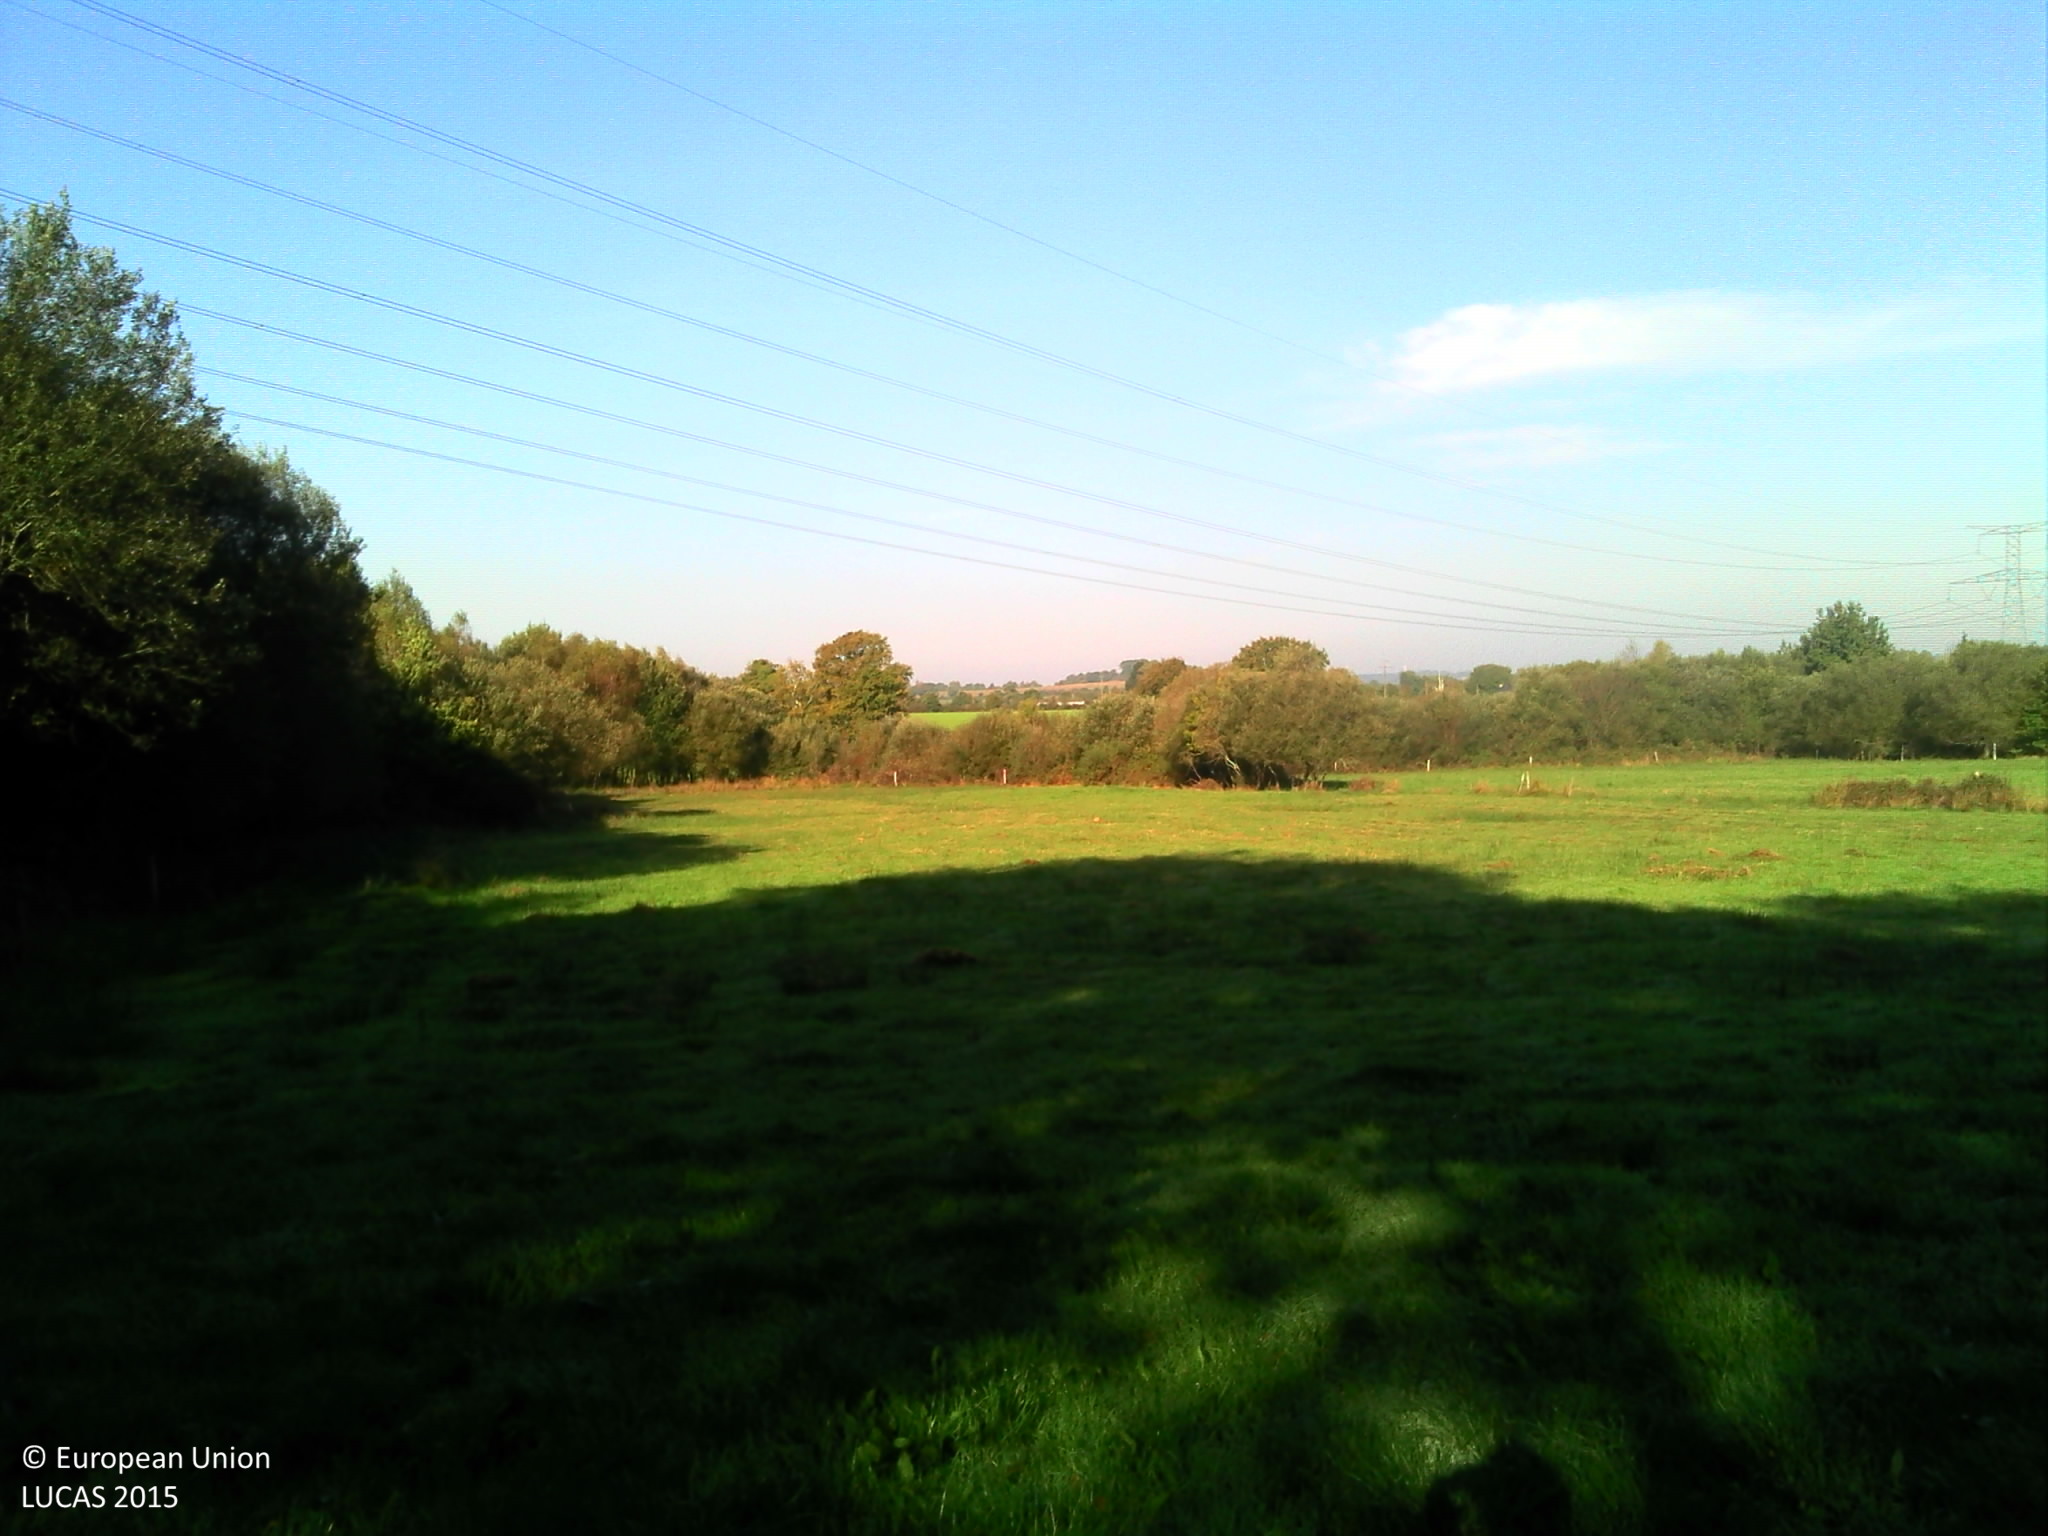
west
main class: Grassland
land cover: Grassland without tree/shrub cover
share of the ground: > 75 %
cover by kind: herbaceous plants 100 %
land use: Agriculture (excluding fallow land and kitchen gardens)
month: October
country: FR
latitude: 47.5685
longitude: -2.1347
